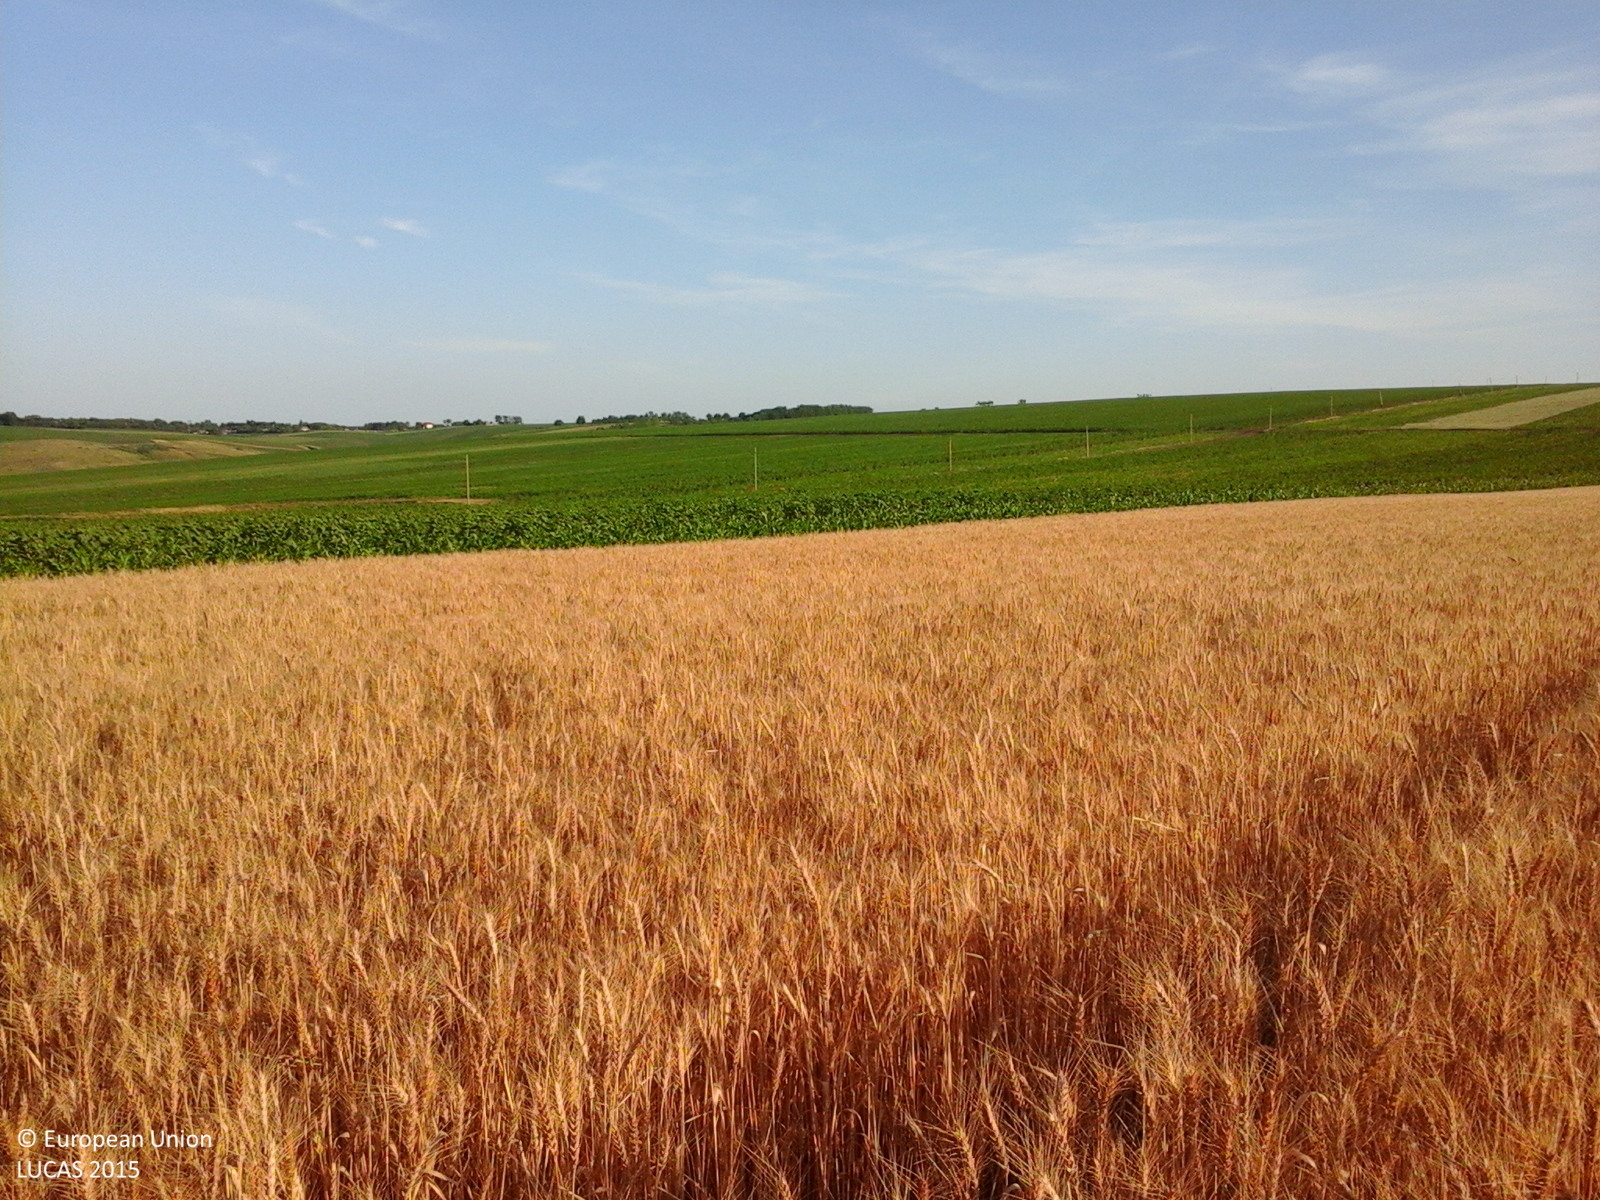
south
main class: Cropland
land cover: Common wheat
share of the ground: > 75 %
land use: Agriculture (excluding fallow land and kitchen gardens)
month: June
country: RO
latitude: 47.4104
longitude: 27.0817
